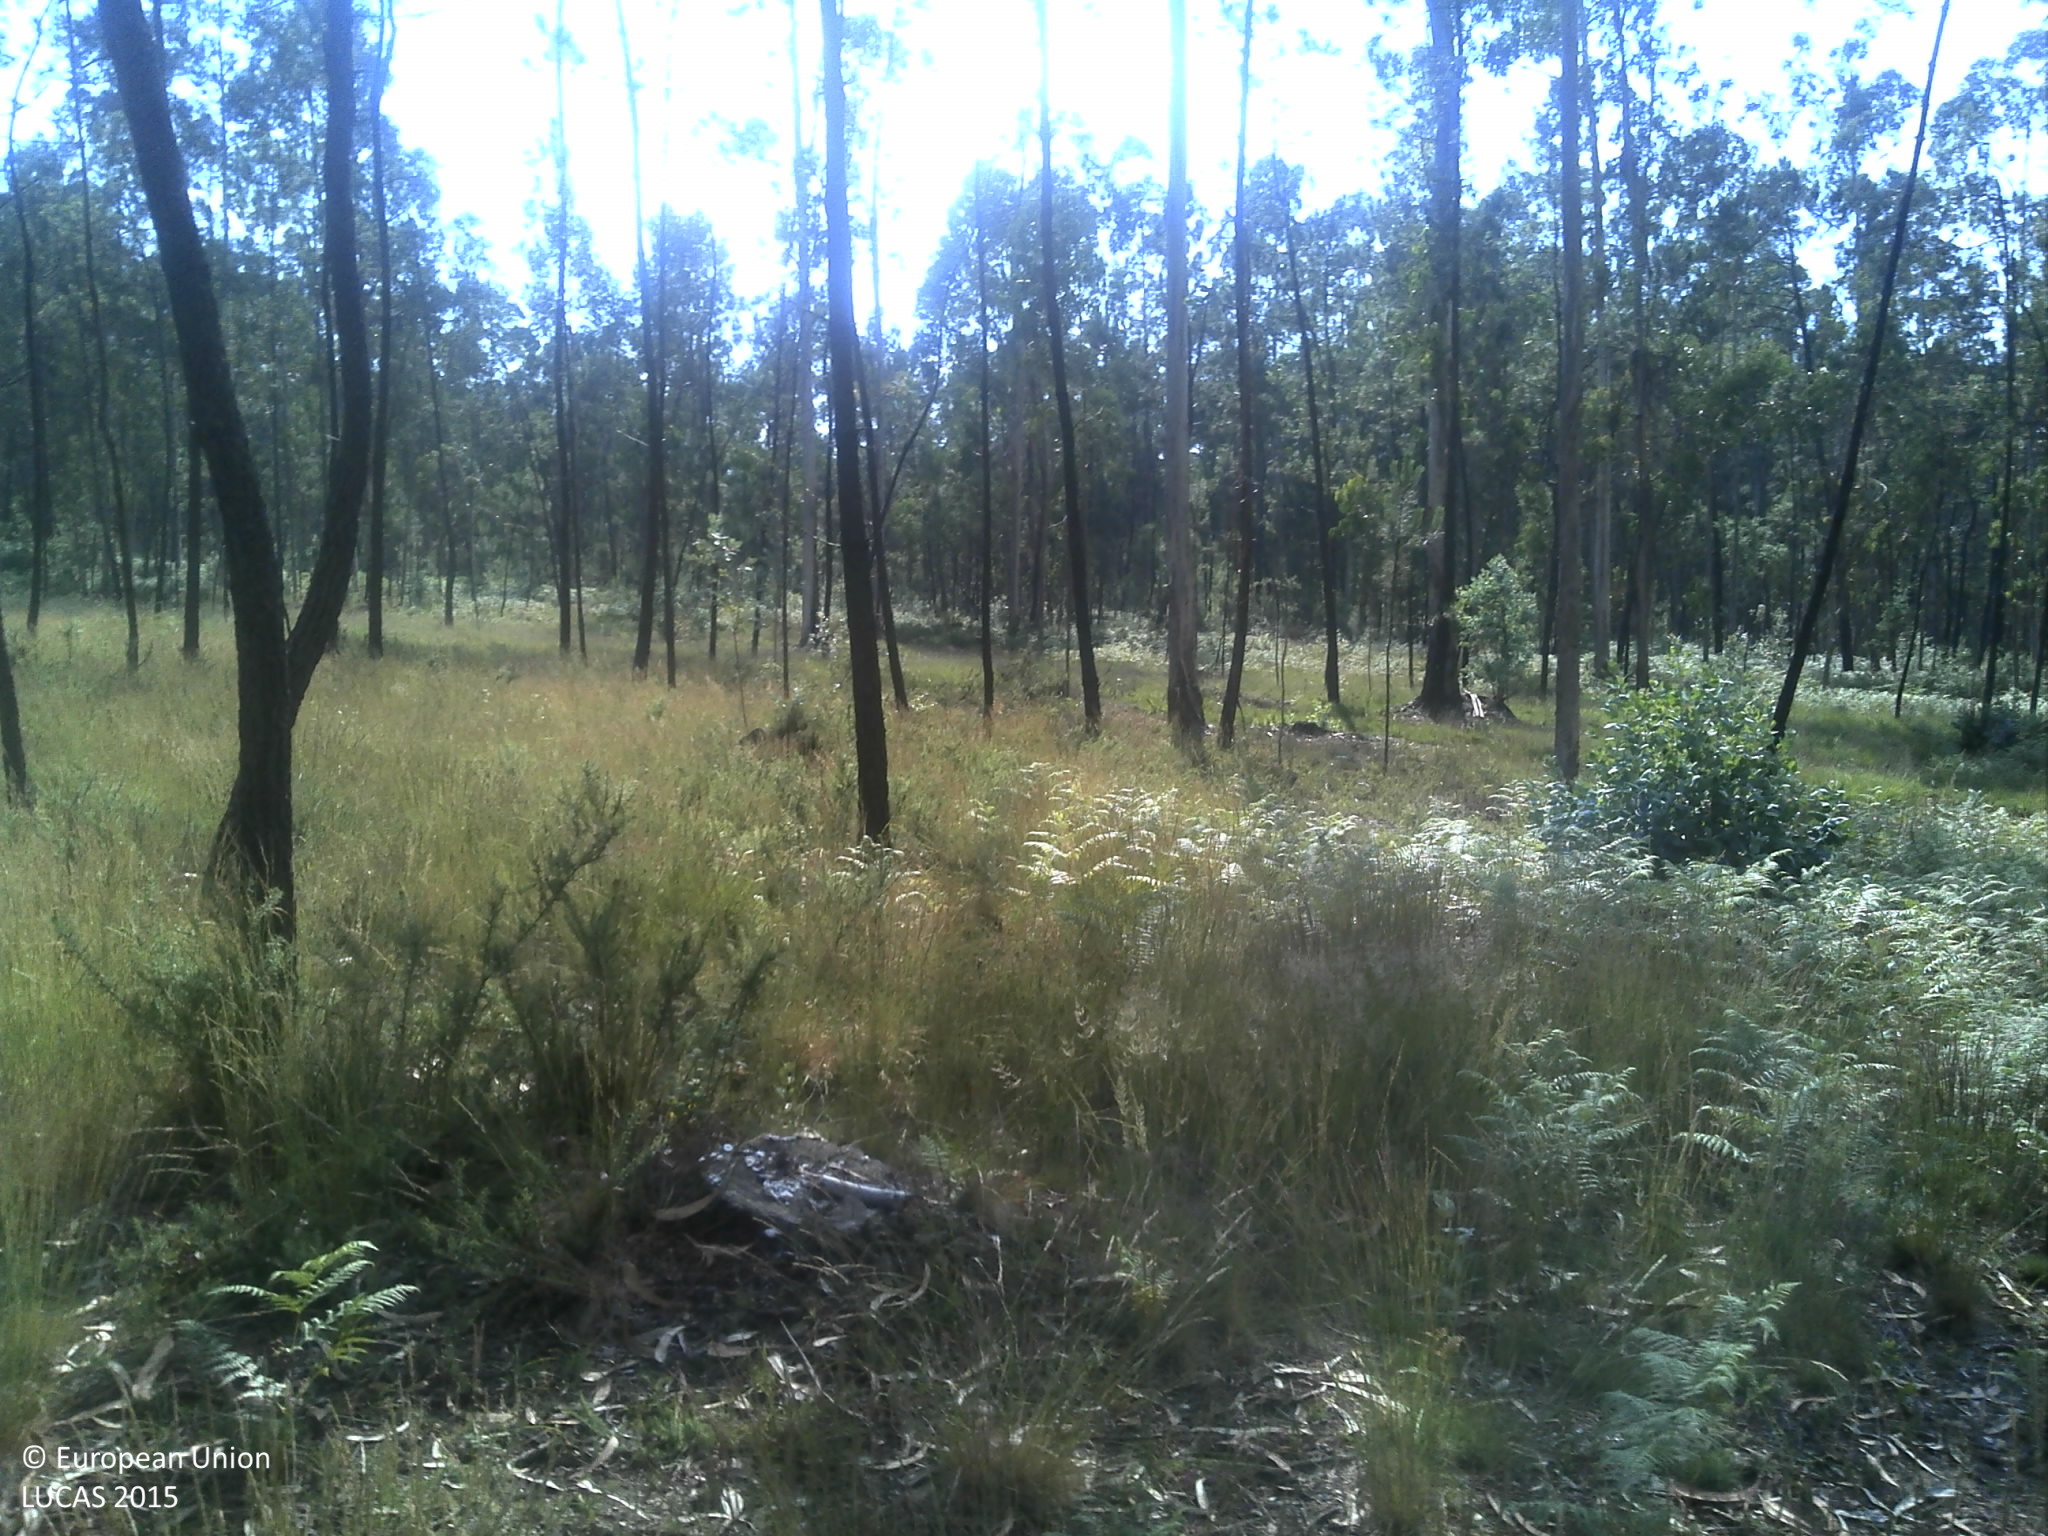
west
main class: Woodland
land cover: Pine dominated mixed woodland
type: coniferous forest of the mediterranean region
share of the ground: 25 - 50 %
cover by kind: coniferous forest trees 75 %, broadleaved forest trees 25 %
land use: Forestry
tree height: > 5 m
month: June
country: PT
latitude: 41.5707
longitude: -8.6412
